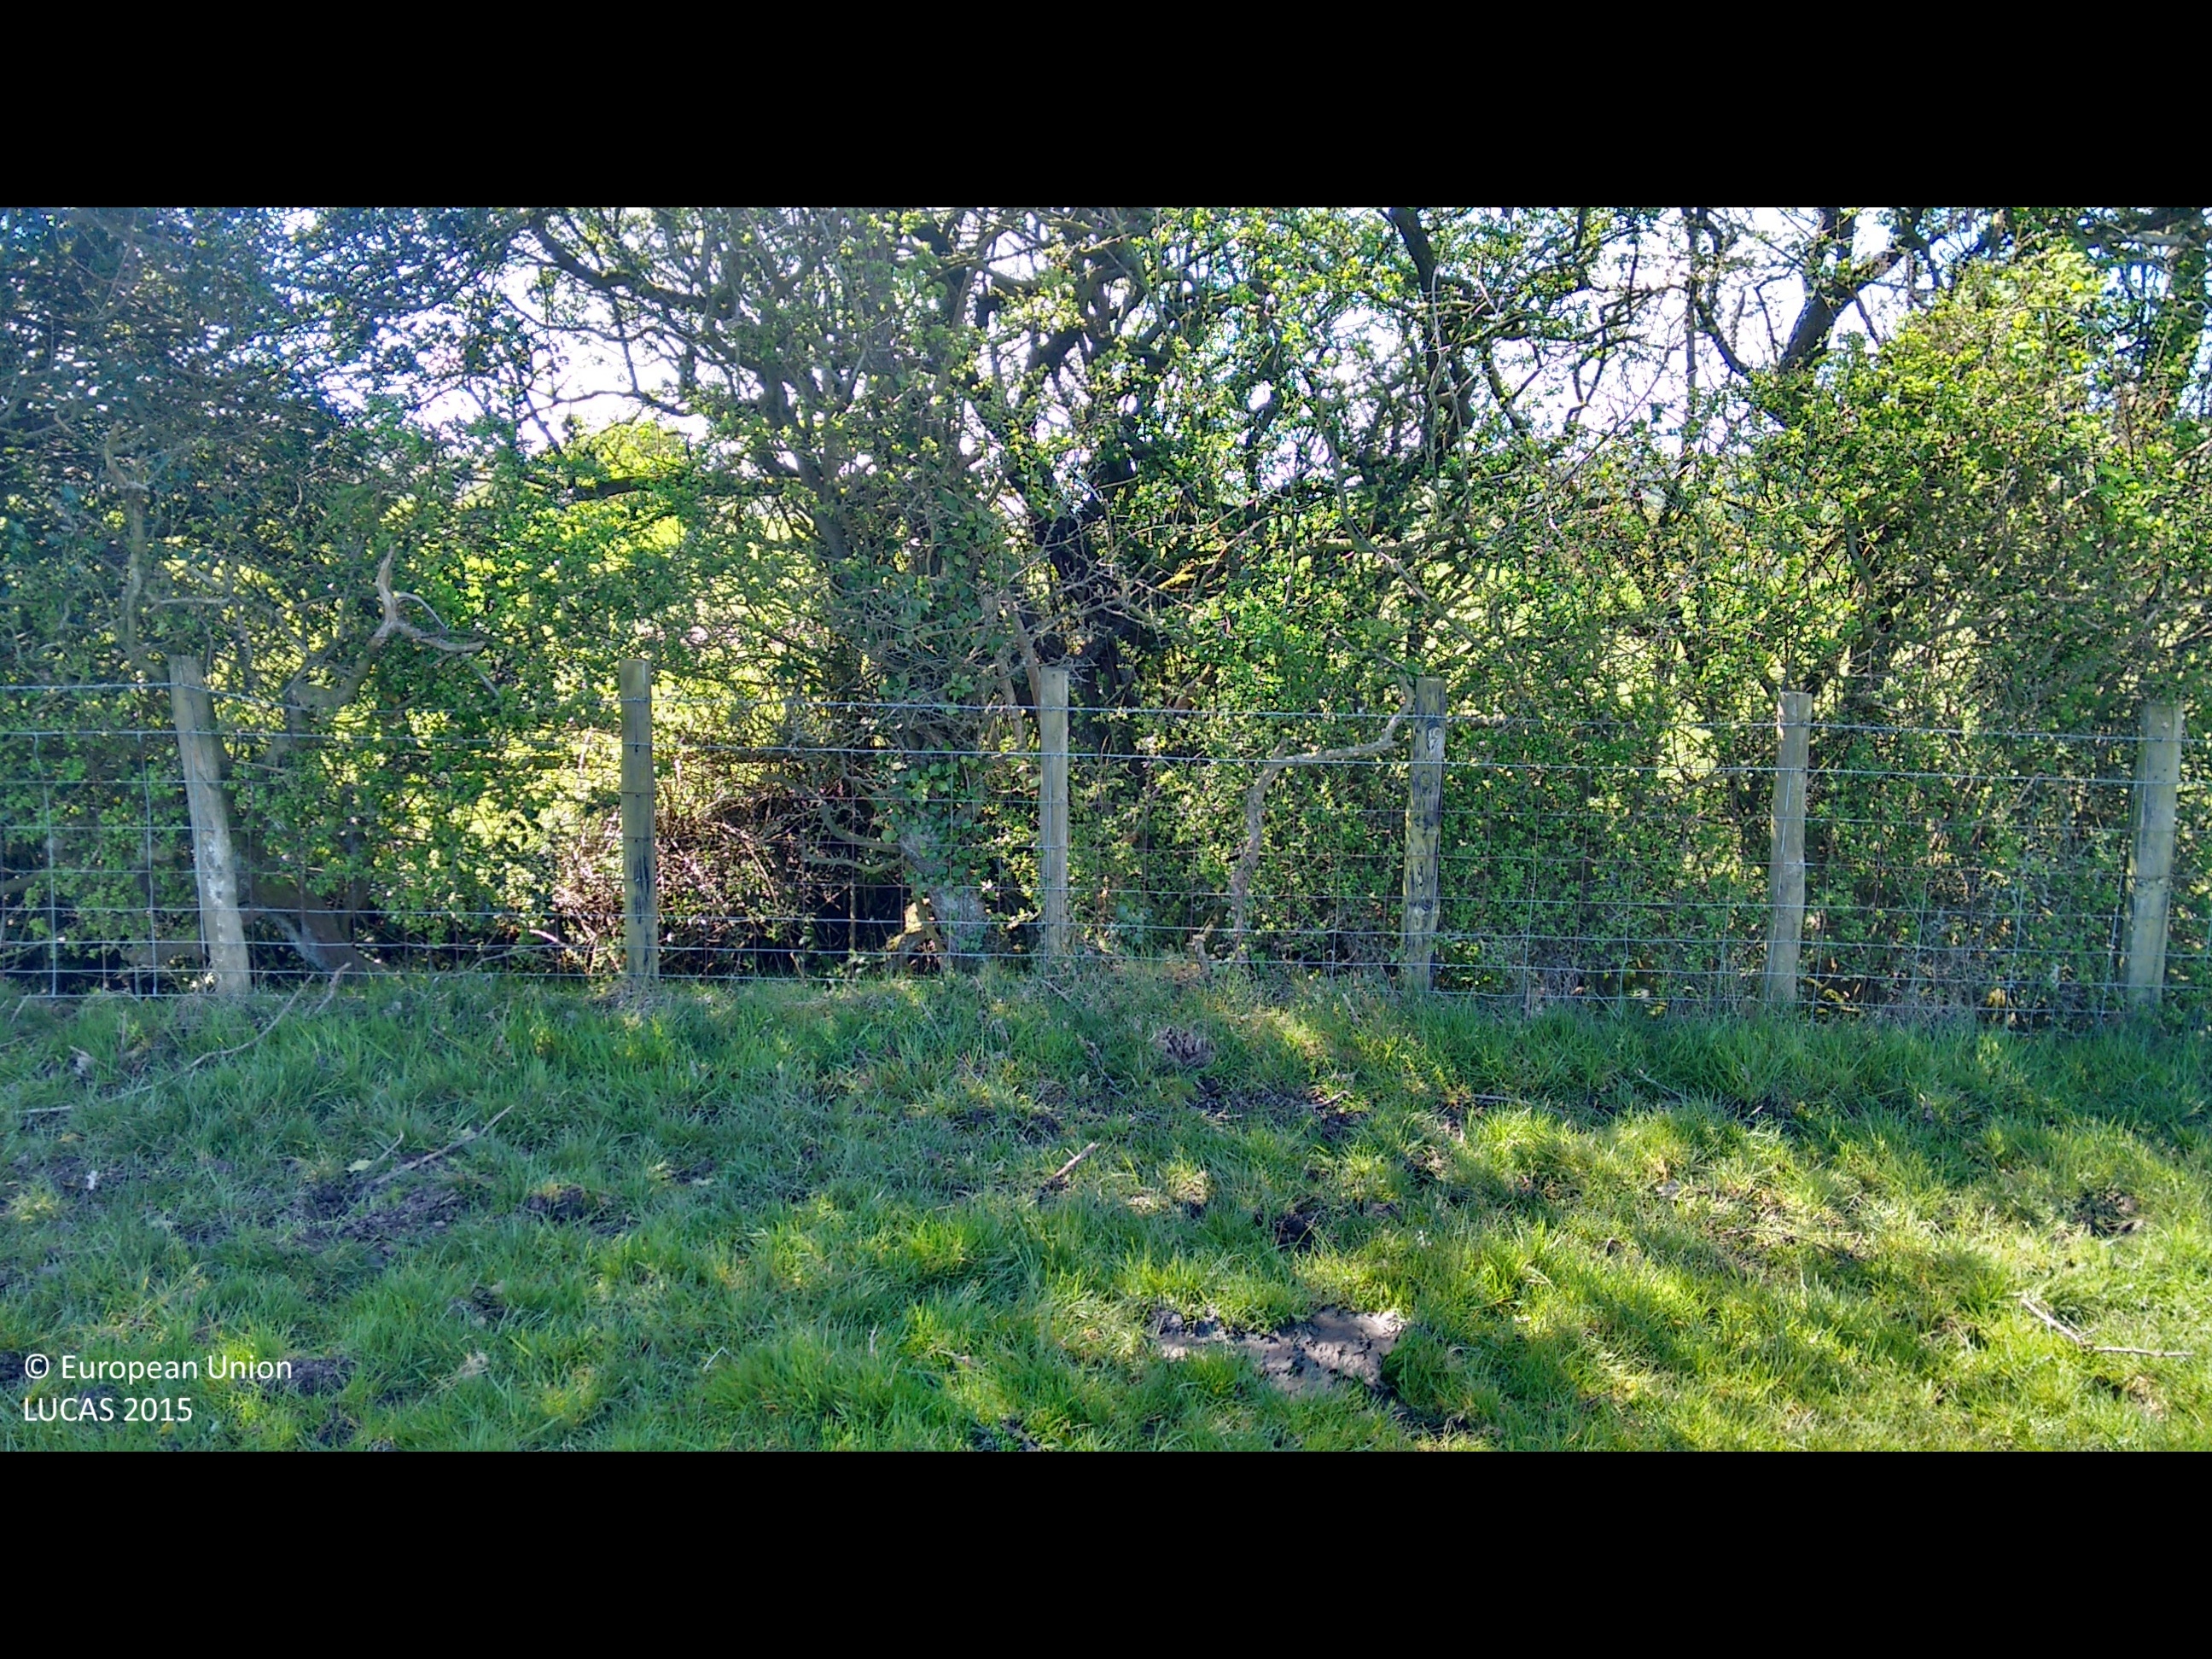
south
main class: Grassland
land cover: Grassland without tree/shrub cover
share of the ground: > 75 %
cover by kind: herbaceous plants 100 %
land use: Agriculture (excluding fallow land and kitchen gardens)
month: May
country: GB
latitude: 53.6707
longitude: -2.5844
